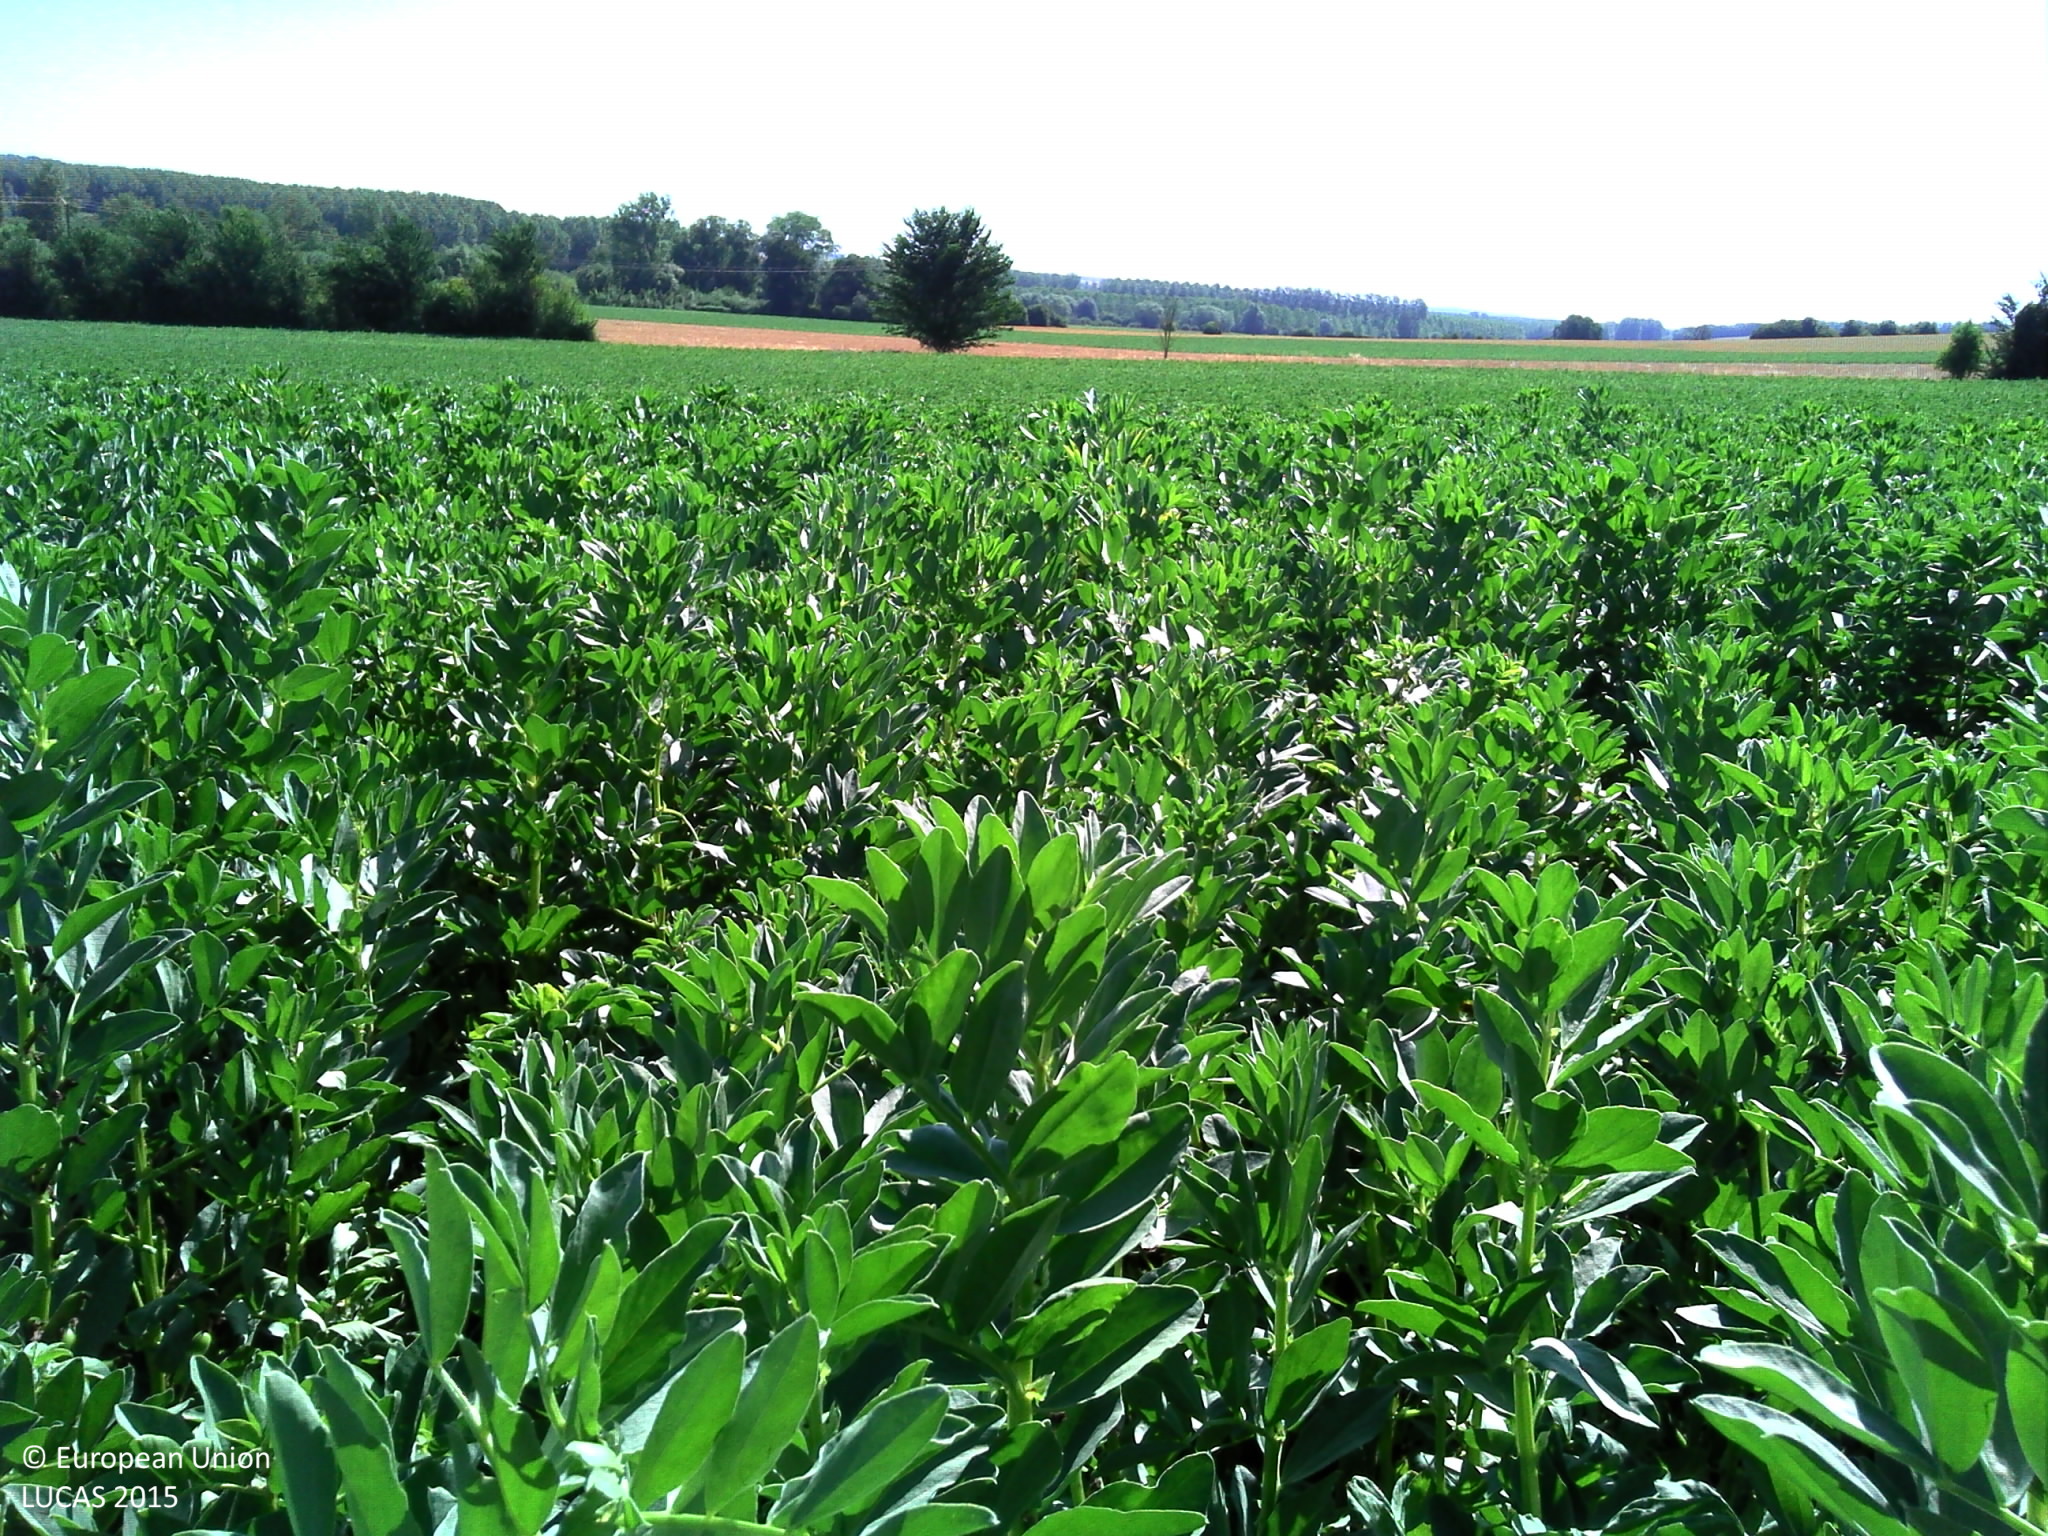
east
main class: Cropland
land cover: Dry pulses
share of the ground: > 75 %
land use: Agriculture (excluding fallow land and kitchen gardens)
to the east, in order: Dry pulses; Grass margins; Tracks; Single bushes/trees; Barley
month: July
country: FR
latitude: 50.2186
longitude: 2.1228
